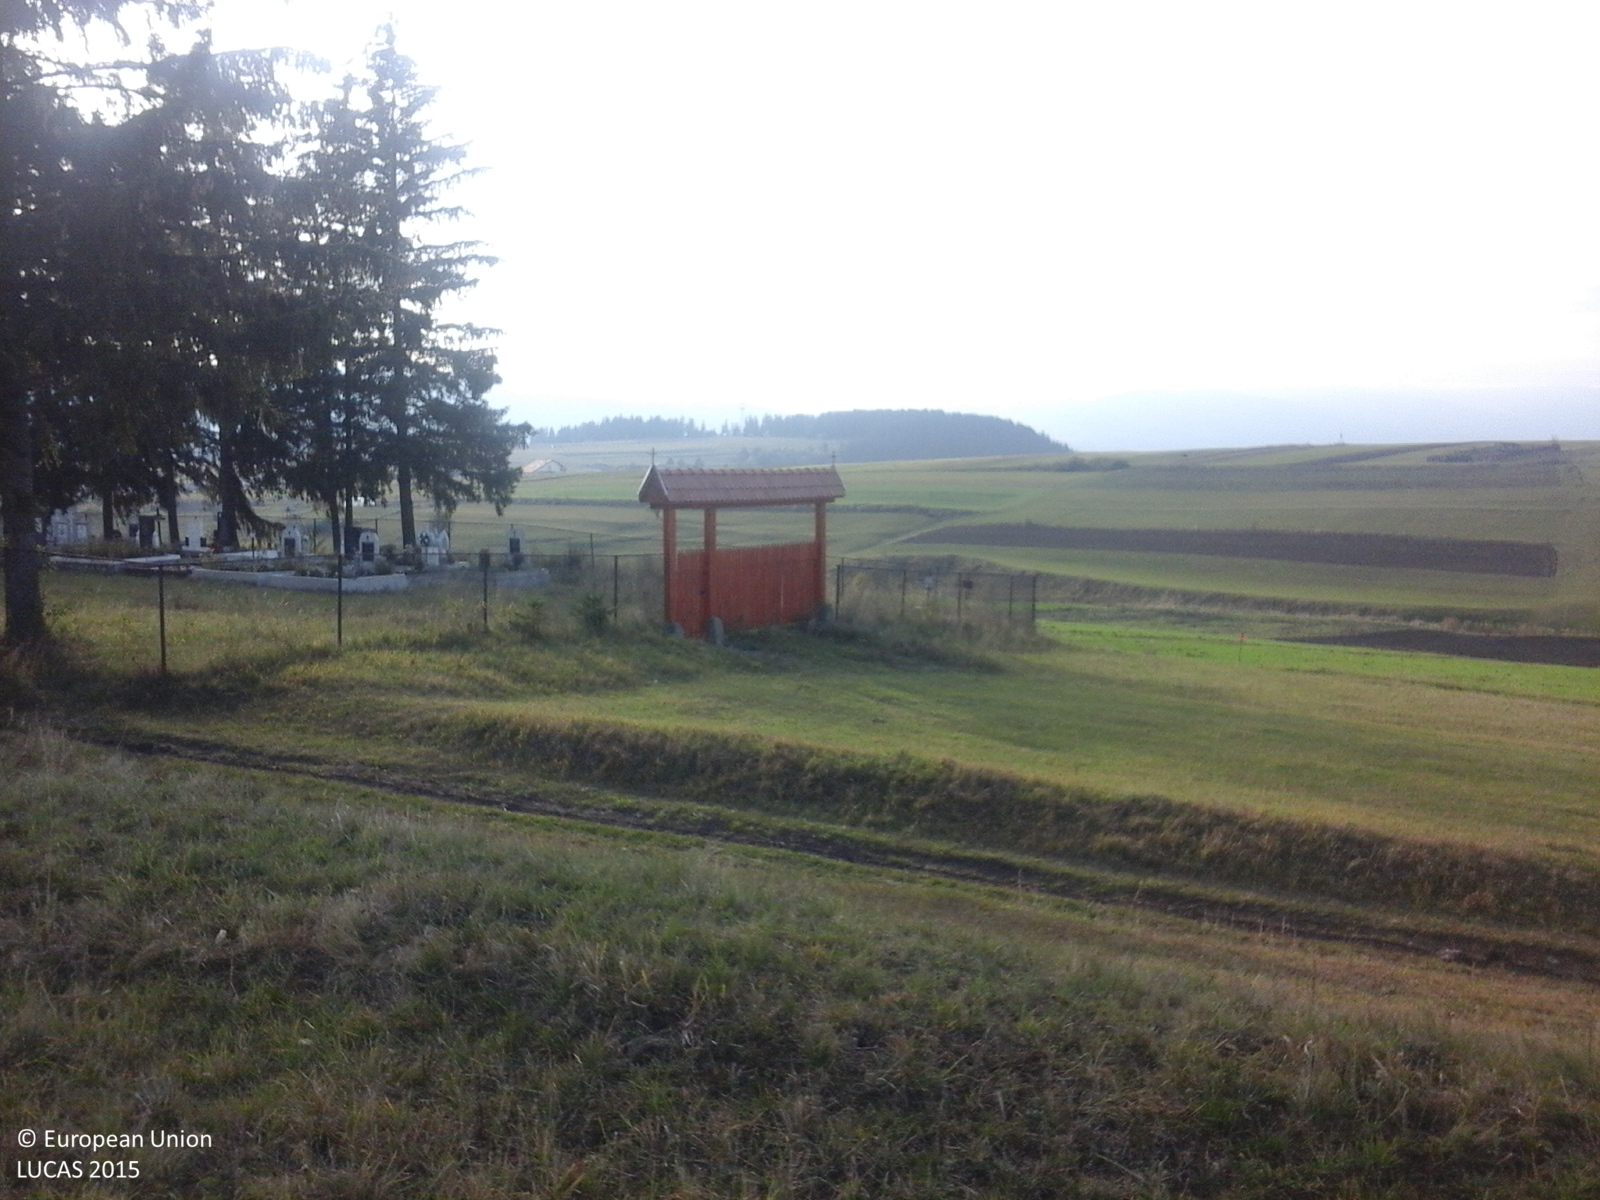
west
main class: Grassland
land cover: Grassland without tree/shrub cover
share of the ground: > 75 %
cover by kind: herbaceous plants 100 %
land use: Agriculture (excluding fallow land and kitchen gardens)
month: October
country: RO
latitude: 46.3516
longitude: 25.8531
